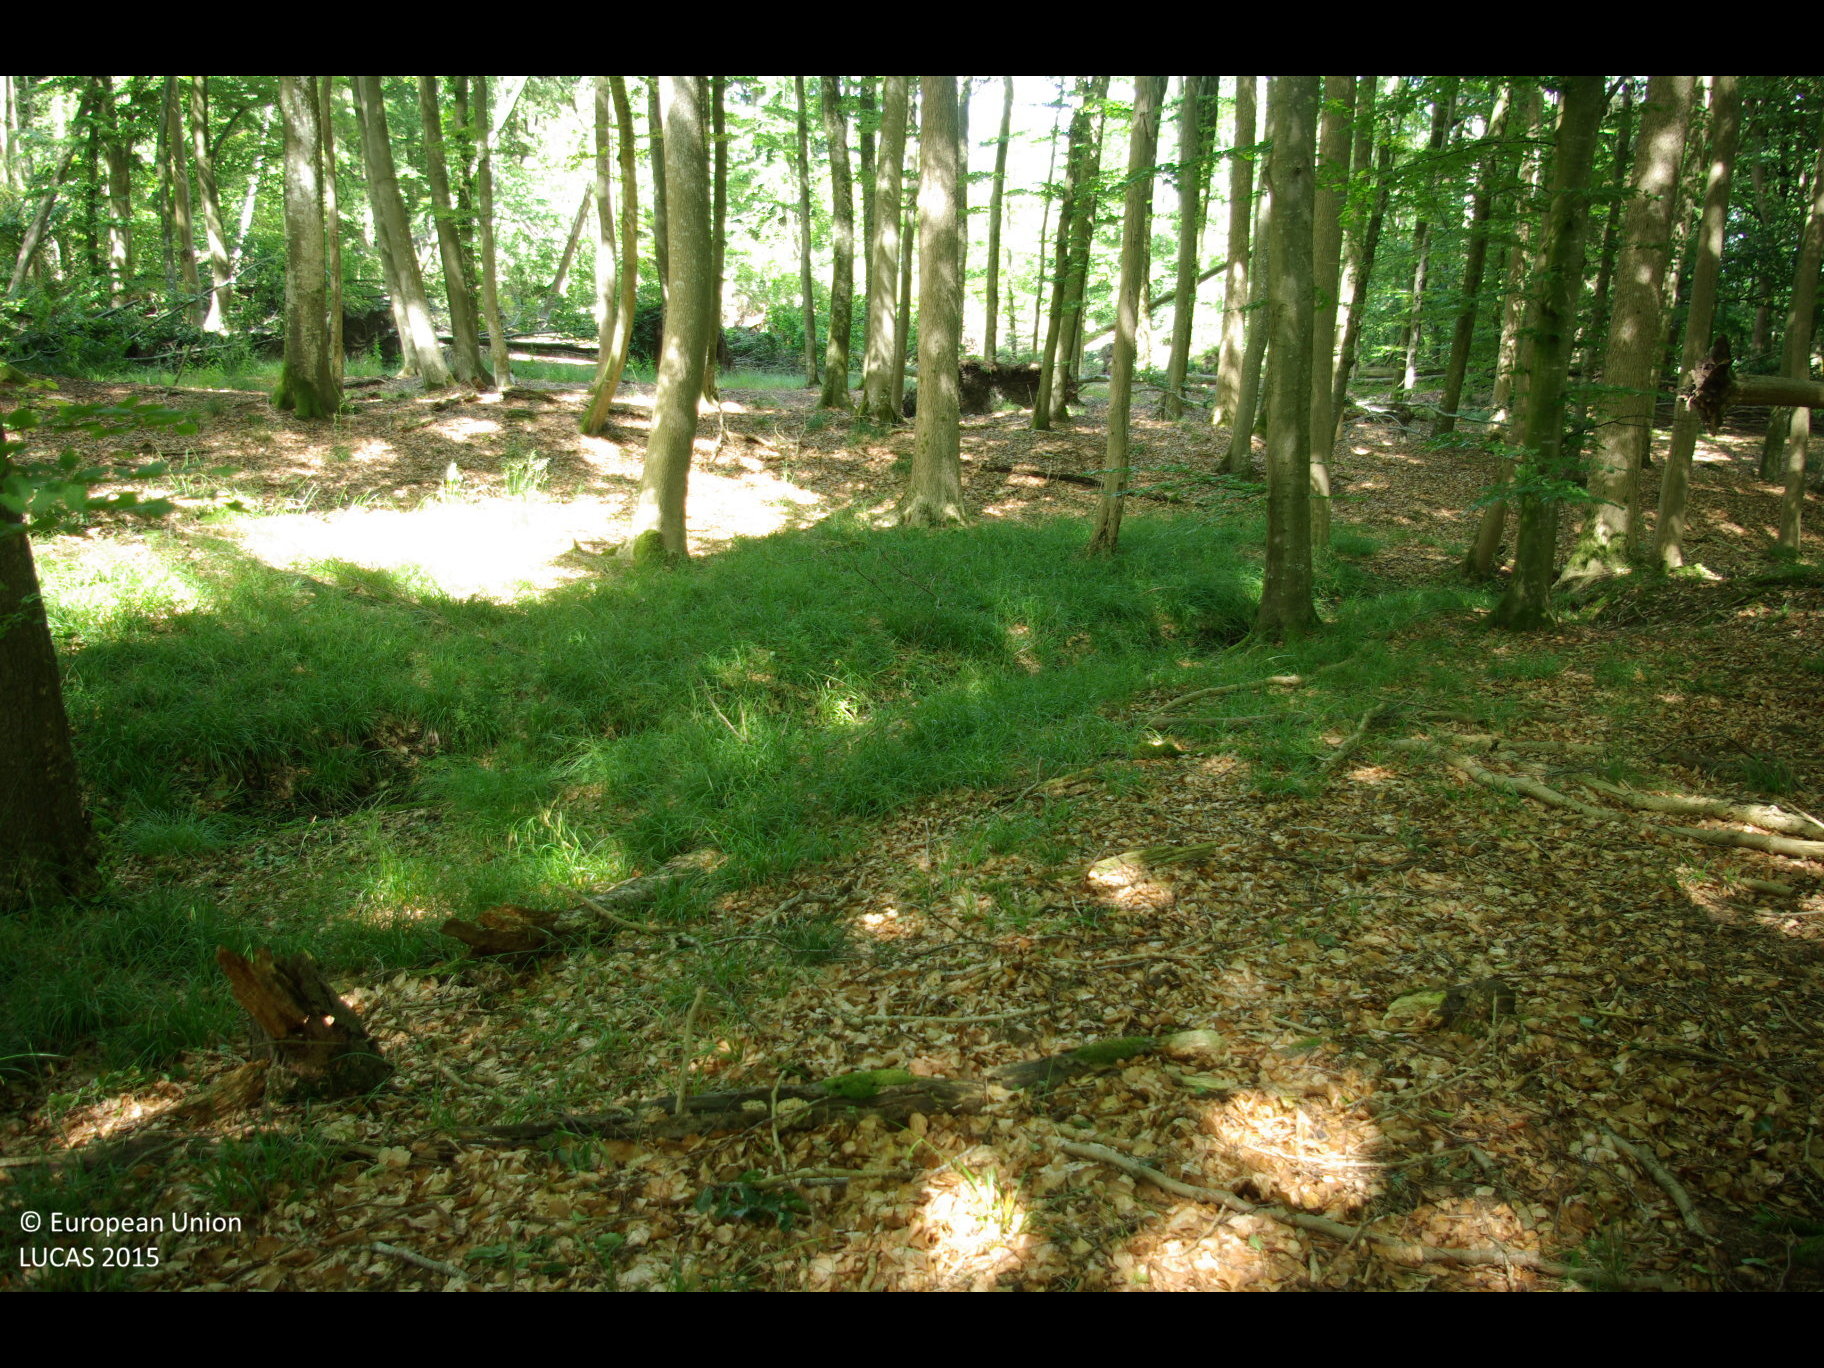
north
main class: Woodland
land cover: Broadleaved woodland
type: mesophytic deciduous forest
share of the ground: > 75 %
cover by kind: broadleaved forest trees 95 %, unconsolidated bare surface 5 %
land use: Forestry
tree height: > 5 m
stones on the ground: 10 - 25 %
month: July
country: DE
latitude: 54.3884
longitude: 9.3075
